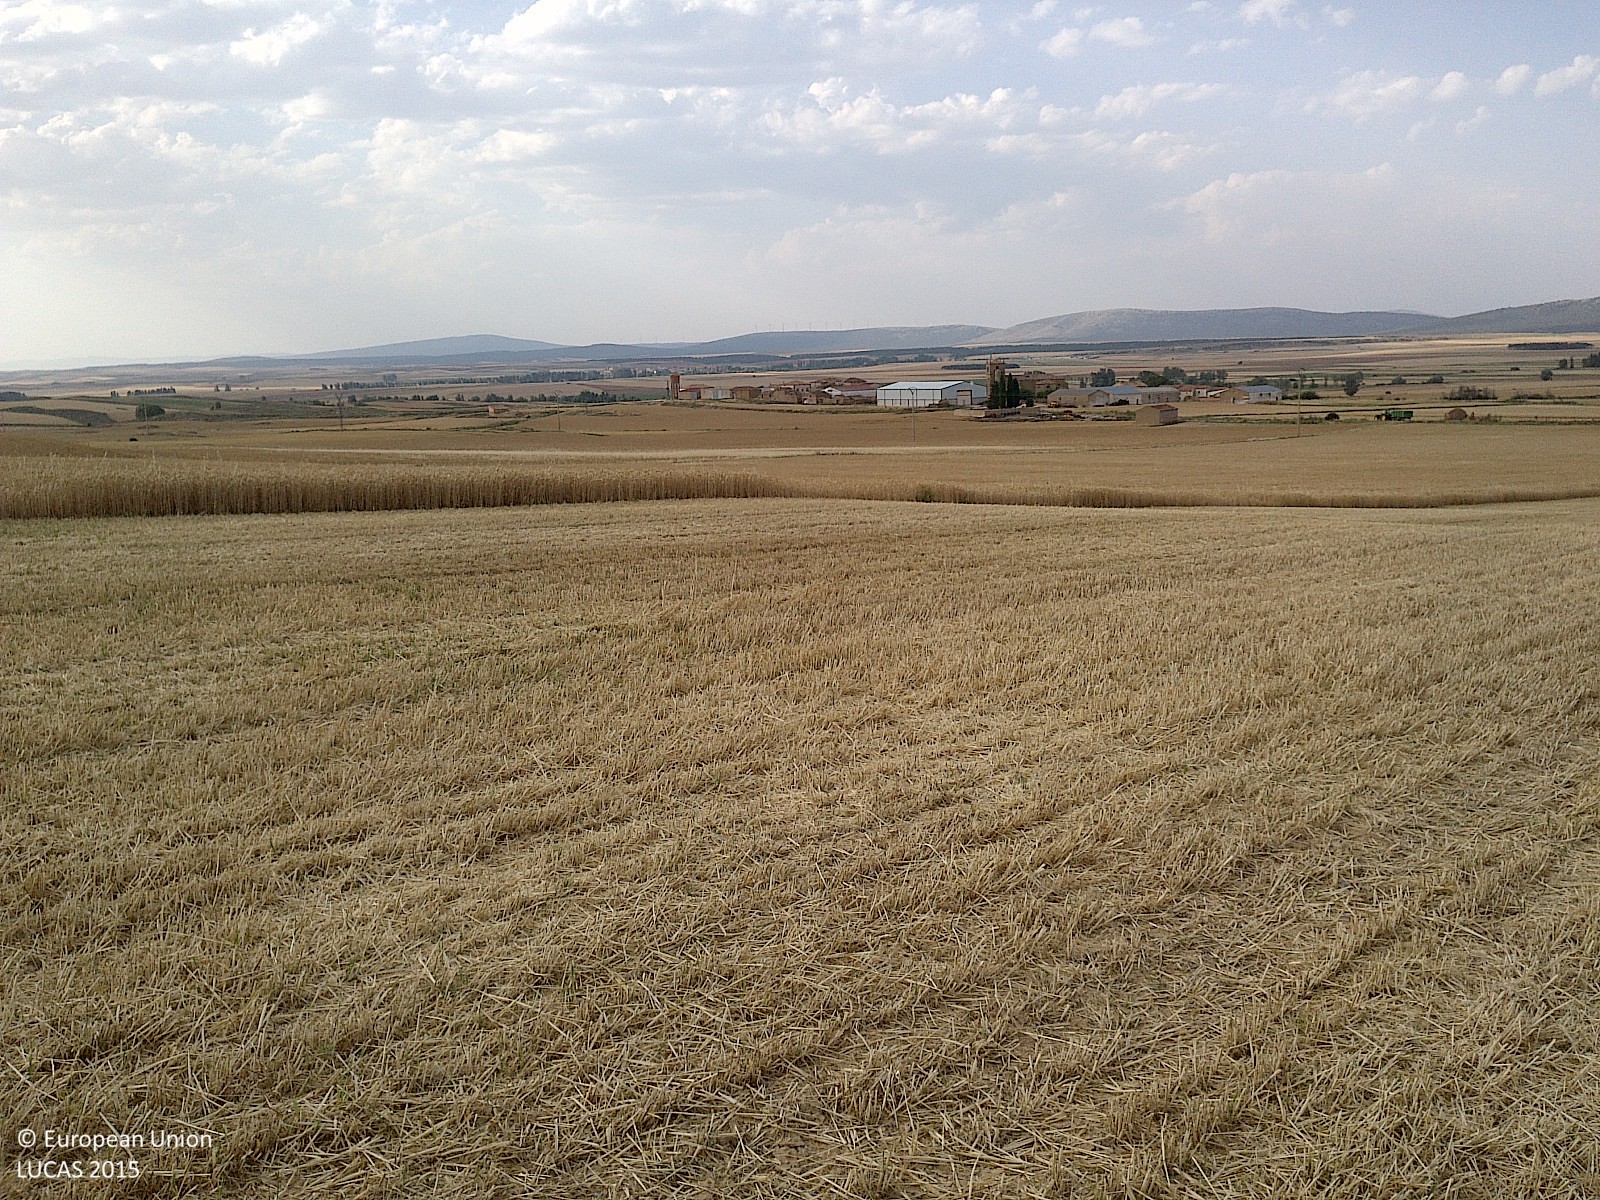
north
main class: Cropland
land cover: Barley
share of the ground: < 10 %
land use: Agriculture (excluding fallow land and kitchen gardens)
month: June
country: ES
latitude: 41.6404
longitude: -2.1952
